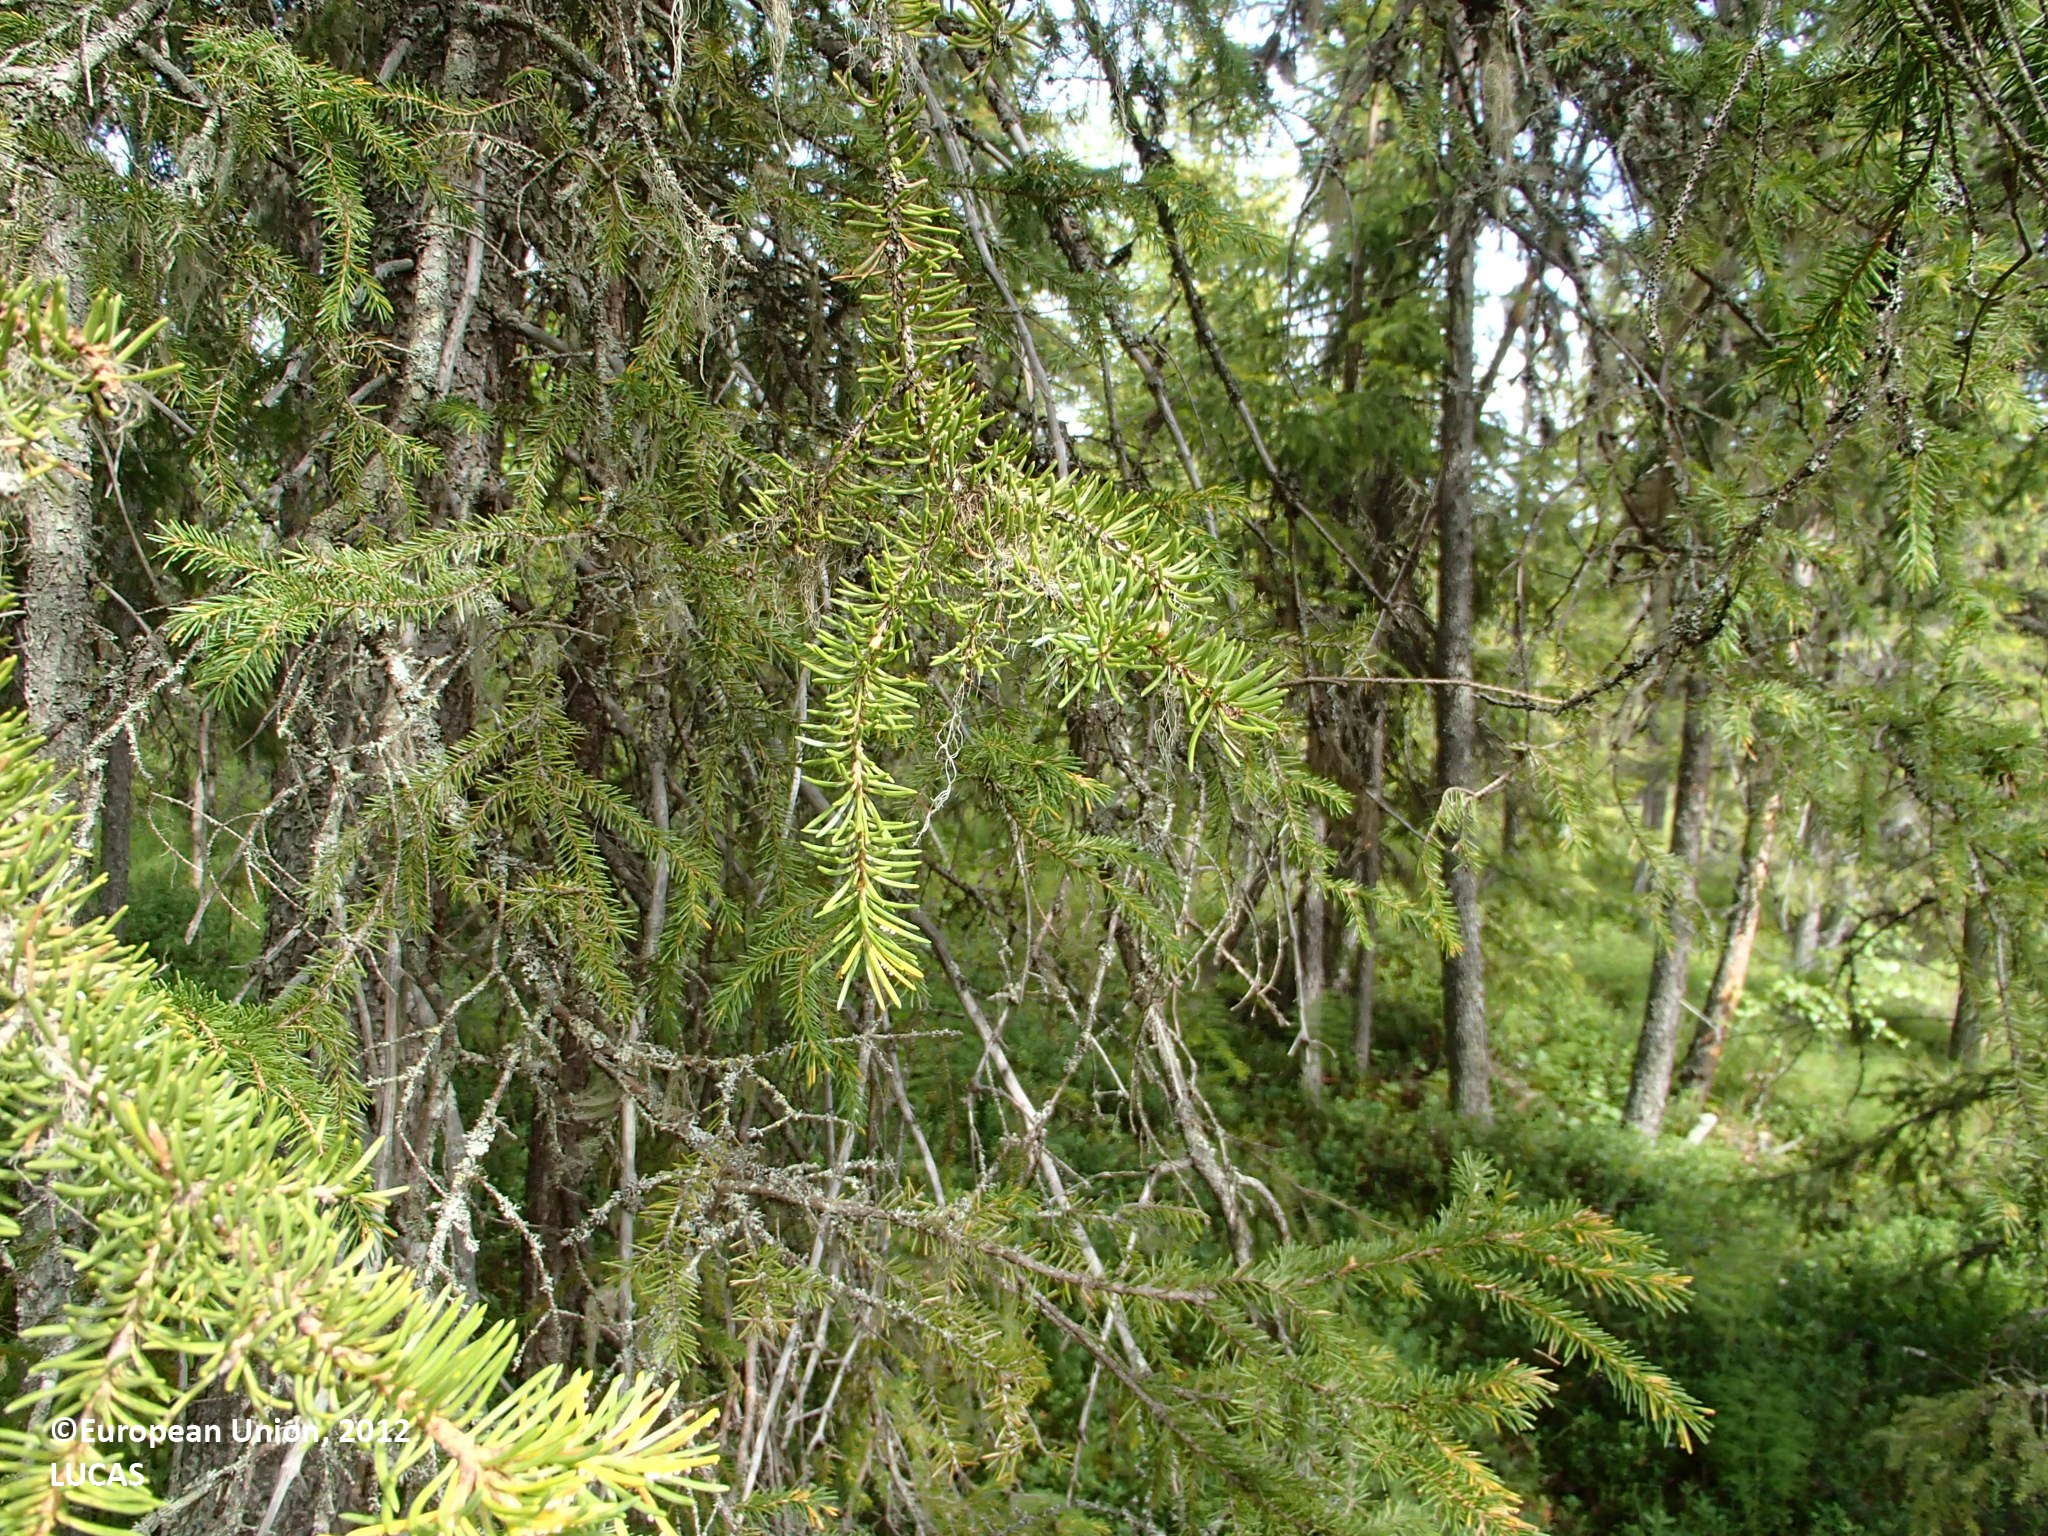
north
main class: Woodland
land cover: Spruce dominated coniferous woodland
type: boreal forest
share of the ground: > 75 %
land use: Forestry
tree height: > 5 m
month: July
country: FI
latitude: 66.4477
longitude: 25.6547
